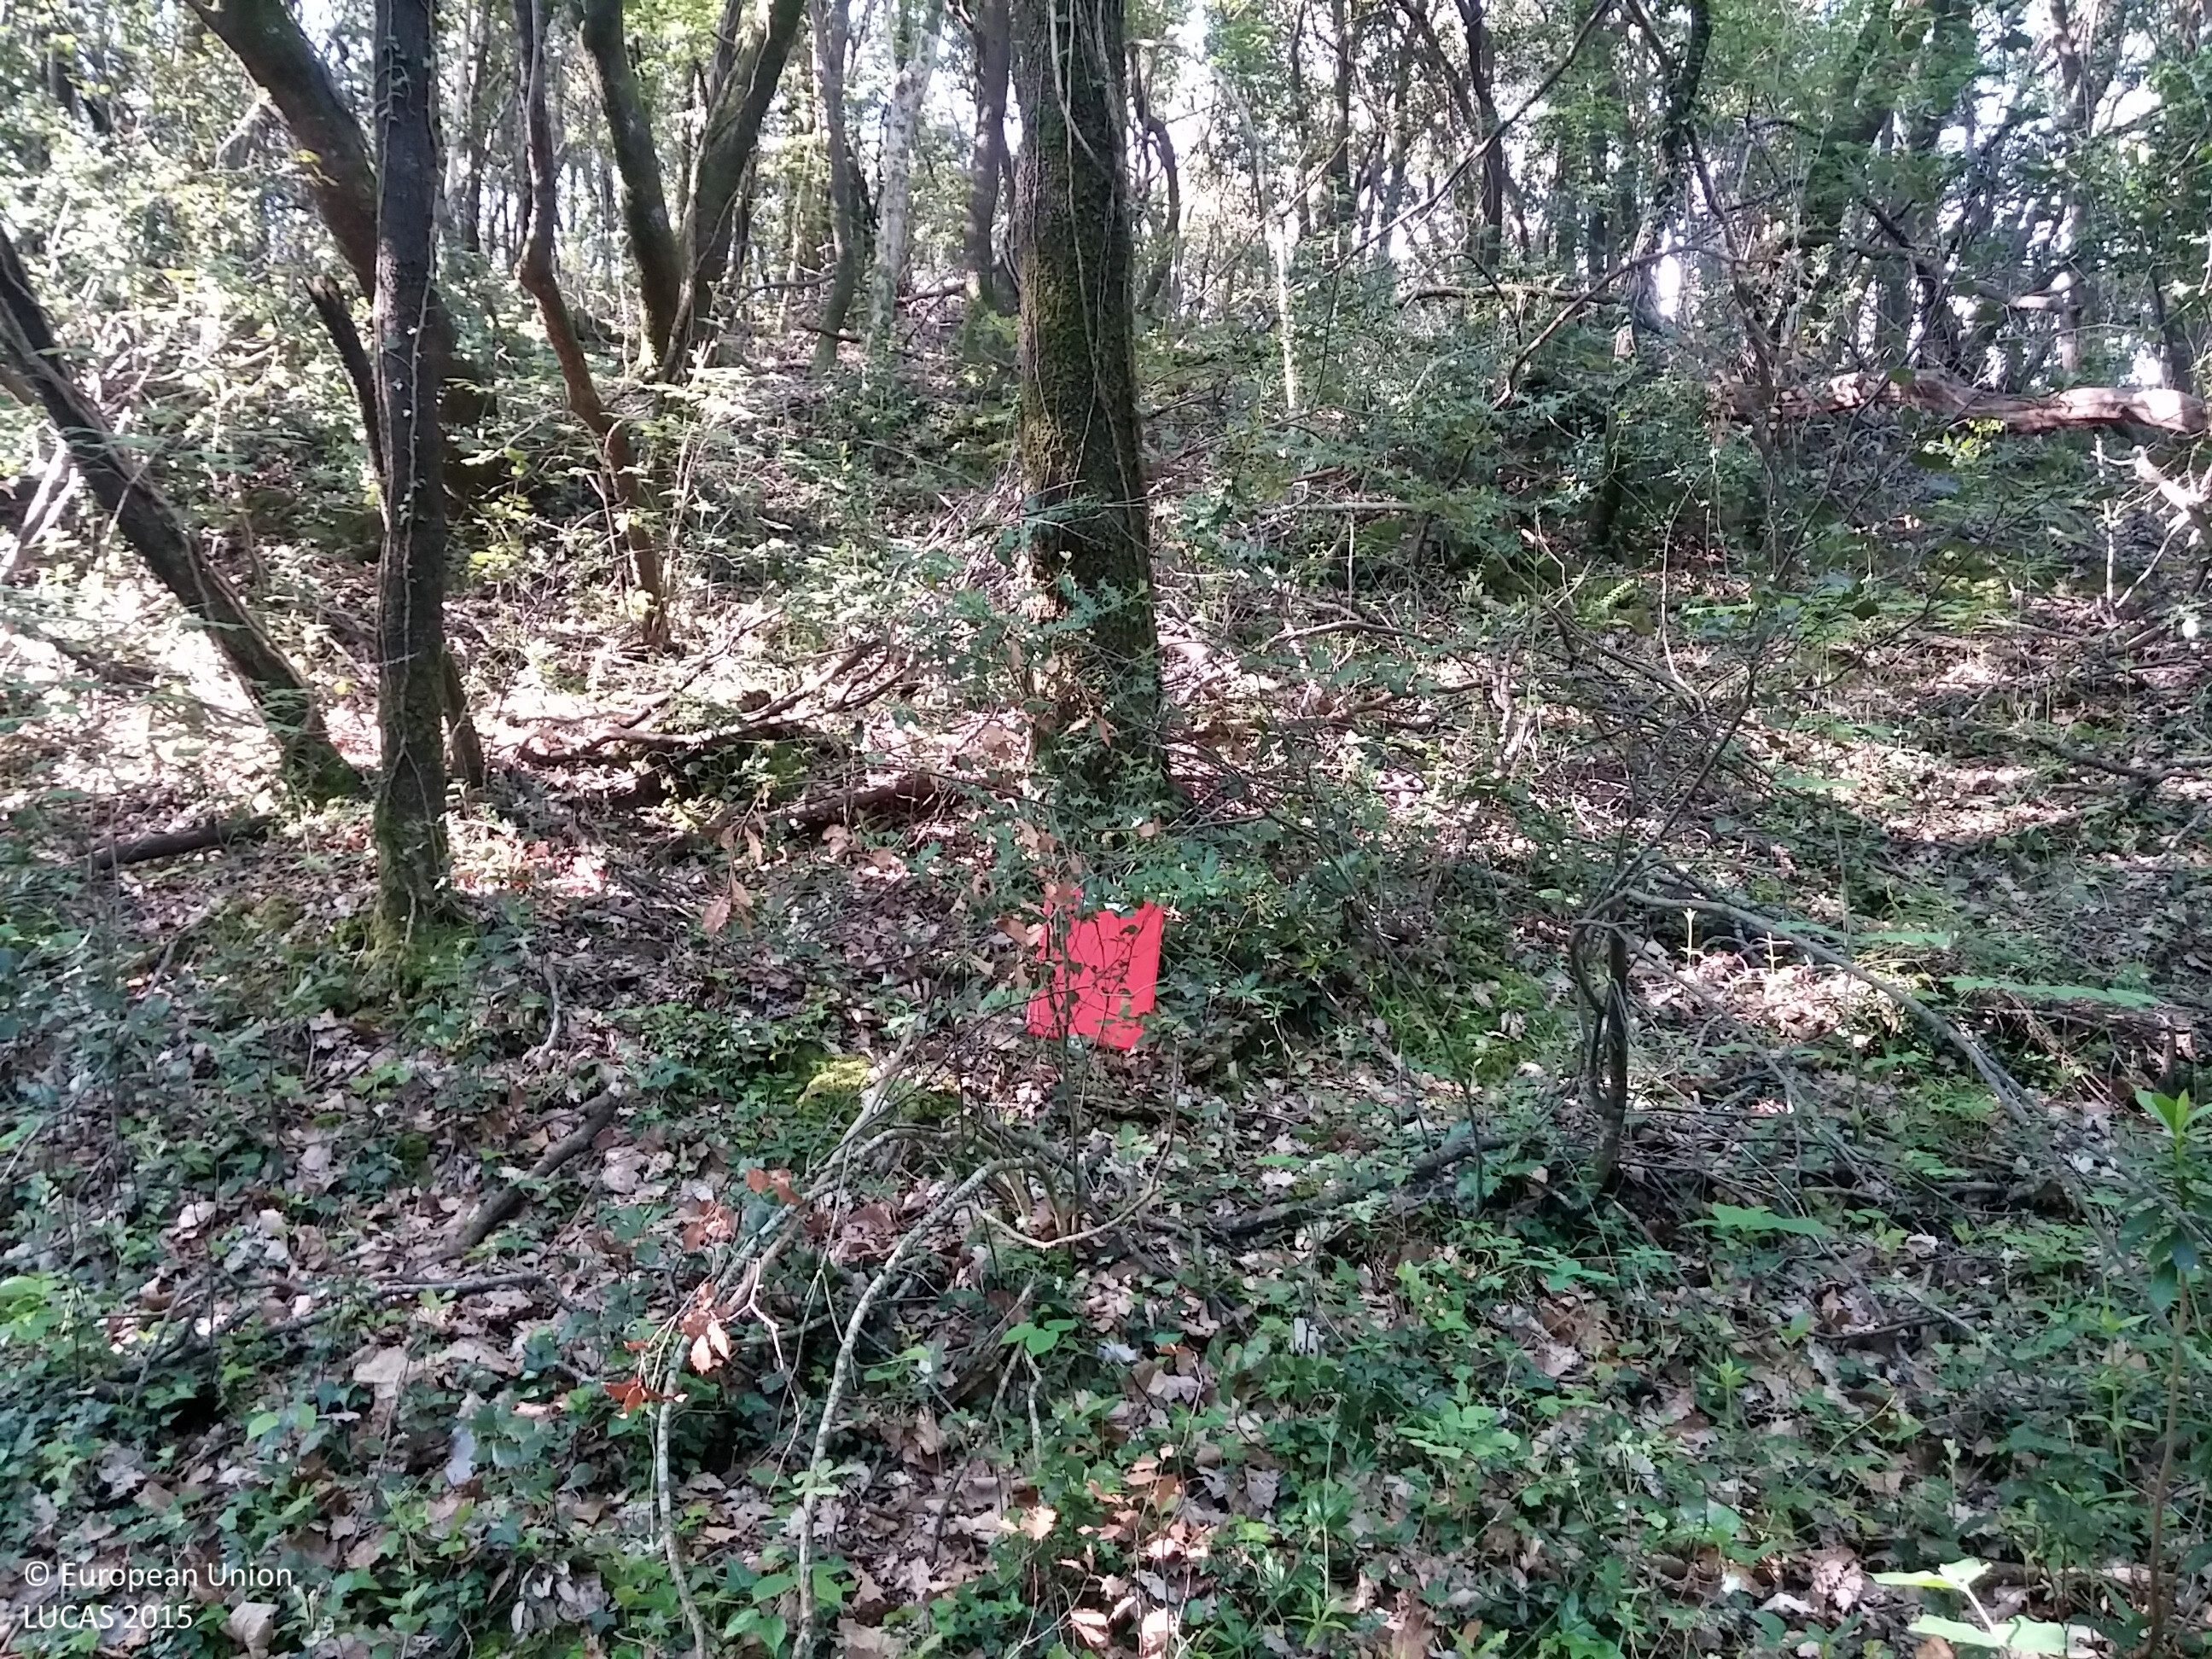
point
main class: Woodland
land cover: Broadleaved woodland
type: thermophilous deciduous forest
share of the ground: > 75 %
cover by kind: broadleaved forest trees 80 %, shrubs 20 %
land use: Forestry
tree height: > 5 m
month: May
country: ES
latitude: 42.1957
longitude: 2.5178
